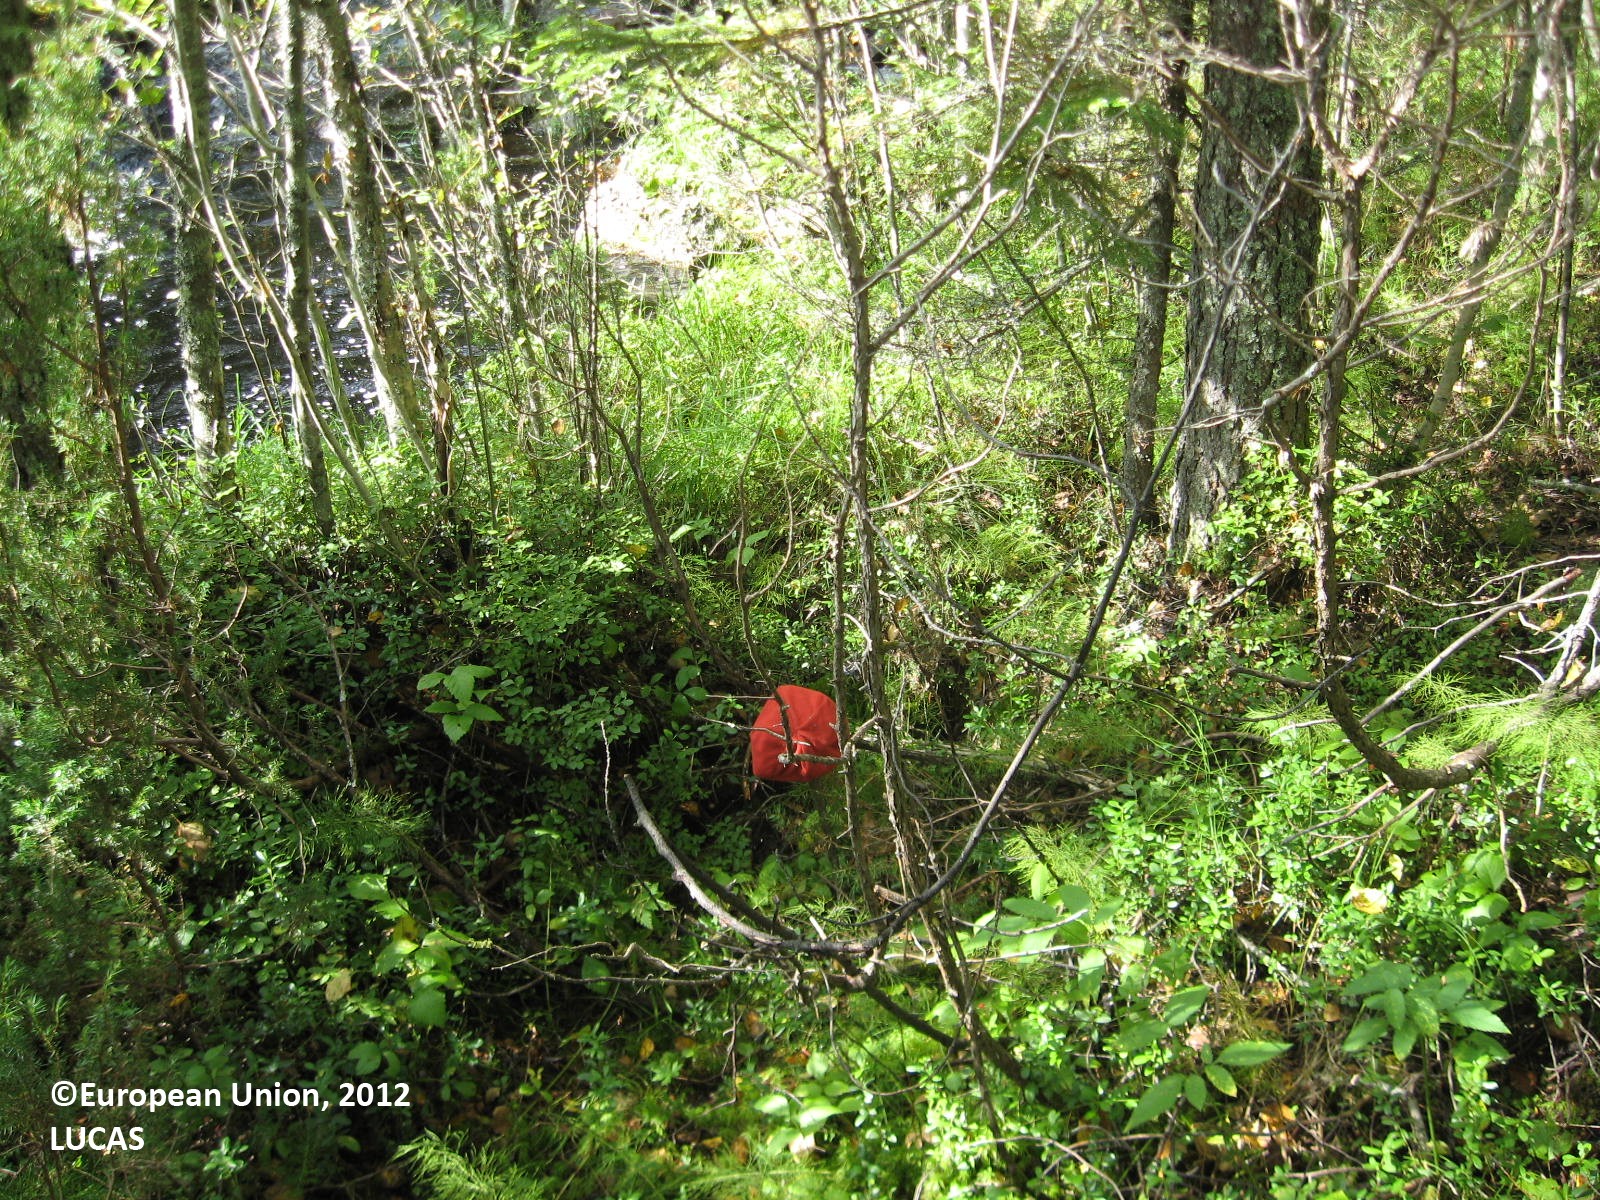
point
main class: Woodland
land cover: Pine dominated mixed woodland
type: boreal forest
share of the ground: > 75 %
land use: Forestry
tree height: > 5 m
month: August
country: FI
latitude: 63.5742
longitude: 30.2571
